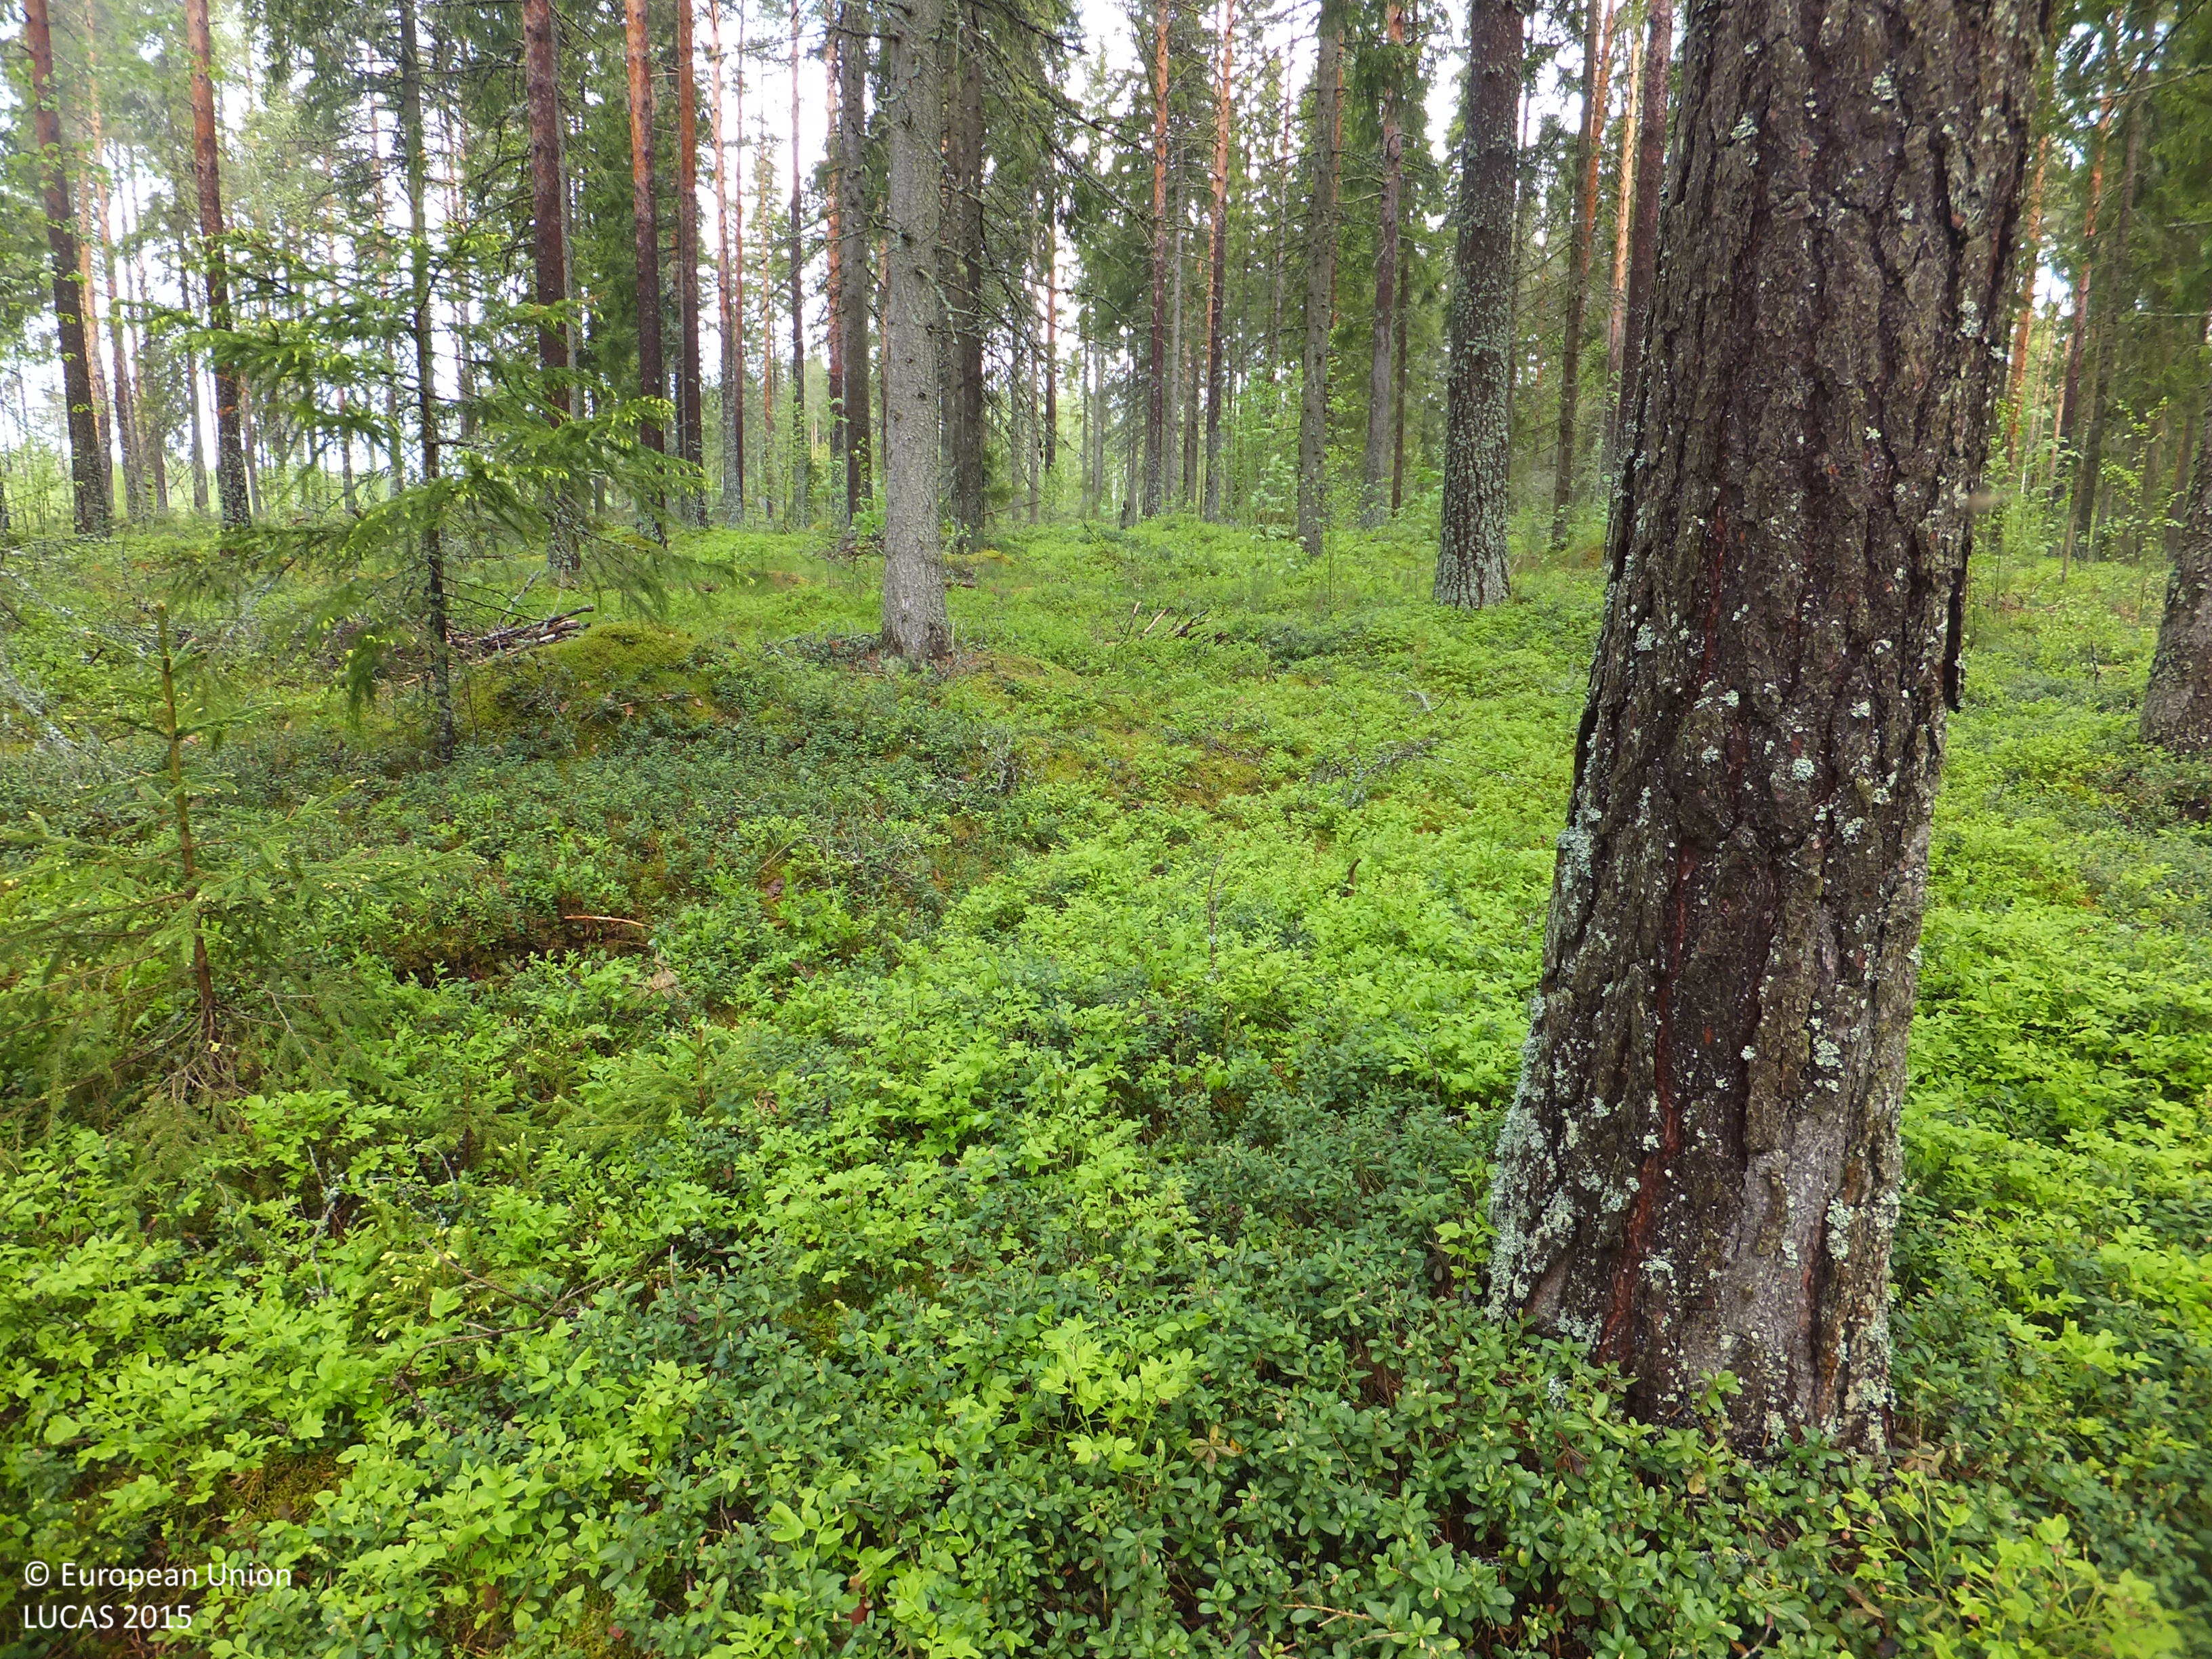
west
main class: Woodland
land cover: Pine dominated coniferous woodland
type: boreal forest
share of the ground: > 75 %
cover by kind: coniferous forest trees 75 %, shrubs 15 %, lichens and mosses 10 %
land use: Forestry
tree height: > 5 m
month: June
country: FI
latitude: 63.5562
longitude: 22.9138
